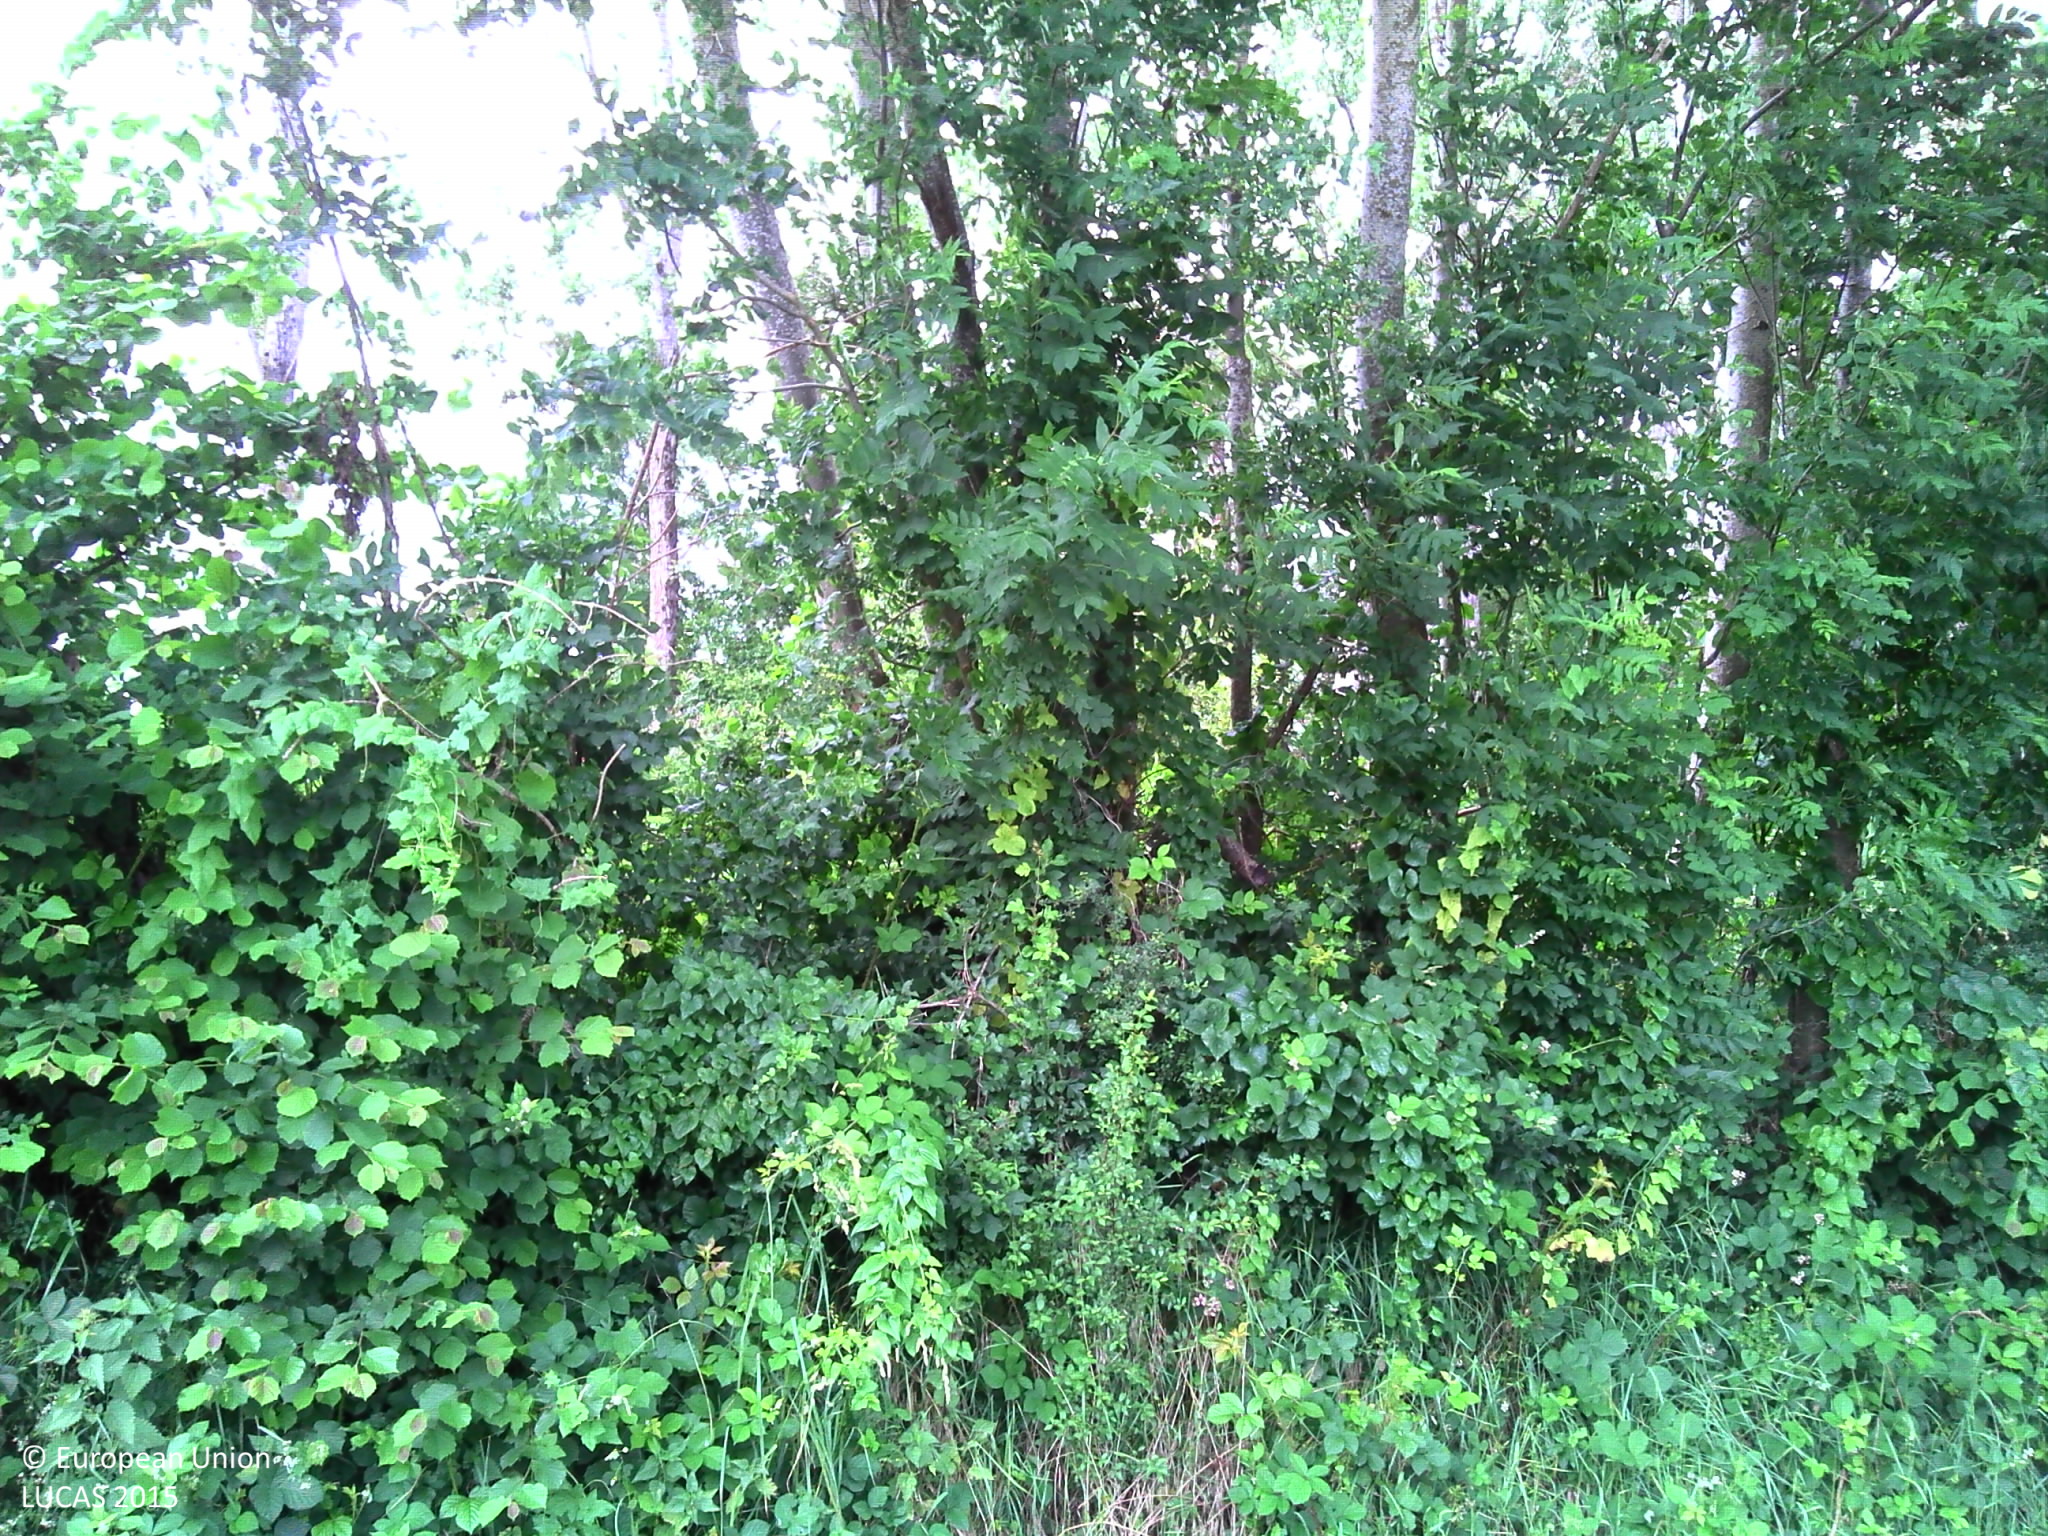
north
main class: Grassland
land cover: Grassland without tree/shrub cover
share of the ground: > 75 %
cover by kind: herbaceous plants 95 %, shrubs 5 %
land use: Agriculture (excluding fallow land and kitchen gardens)
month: June
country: FR
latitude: 46.1754
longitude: 2.9903
